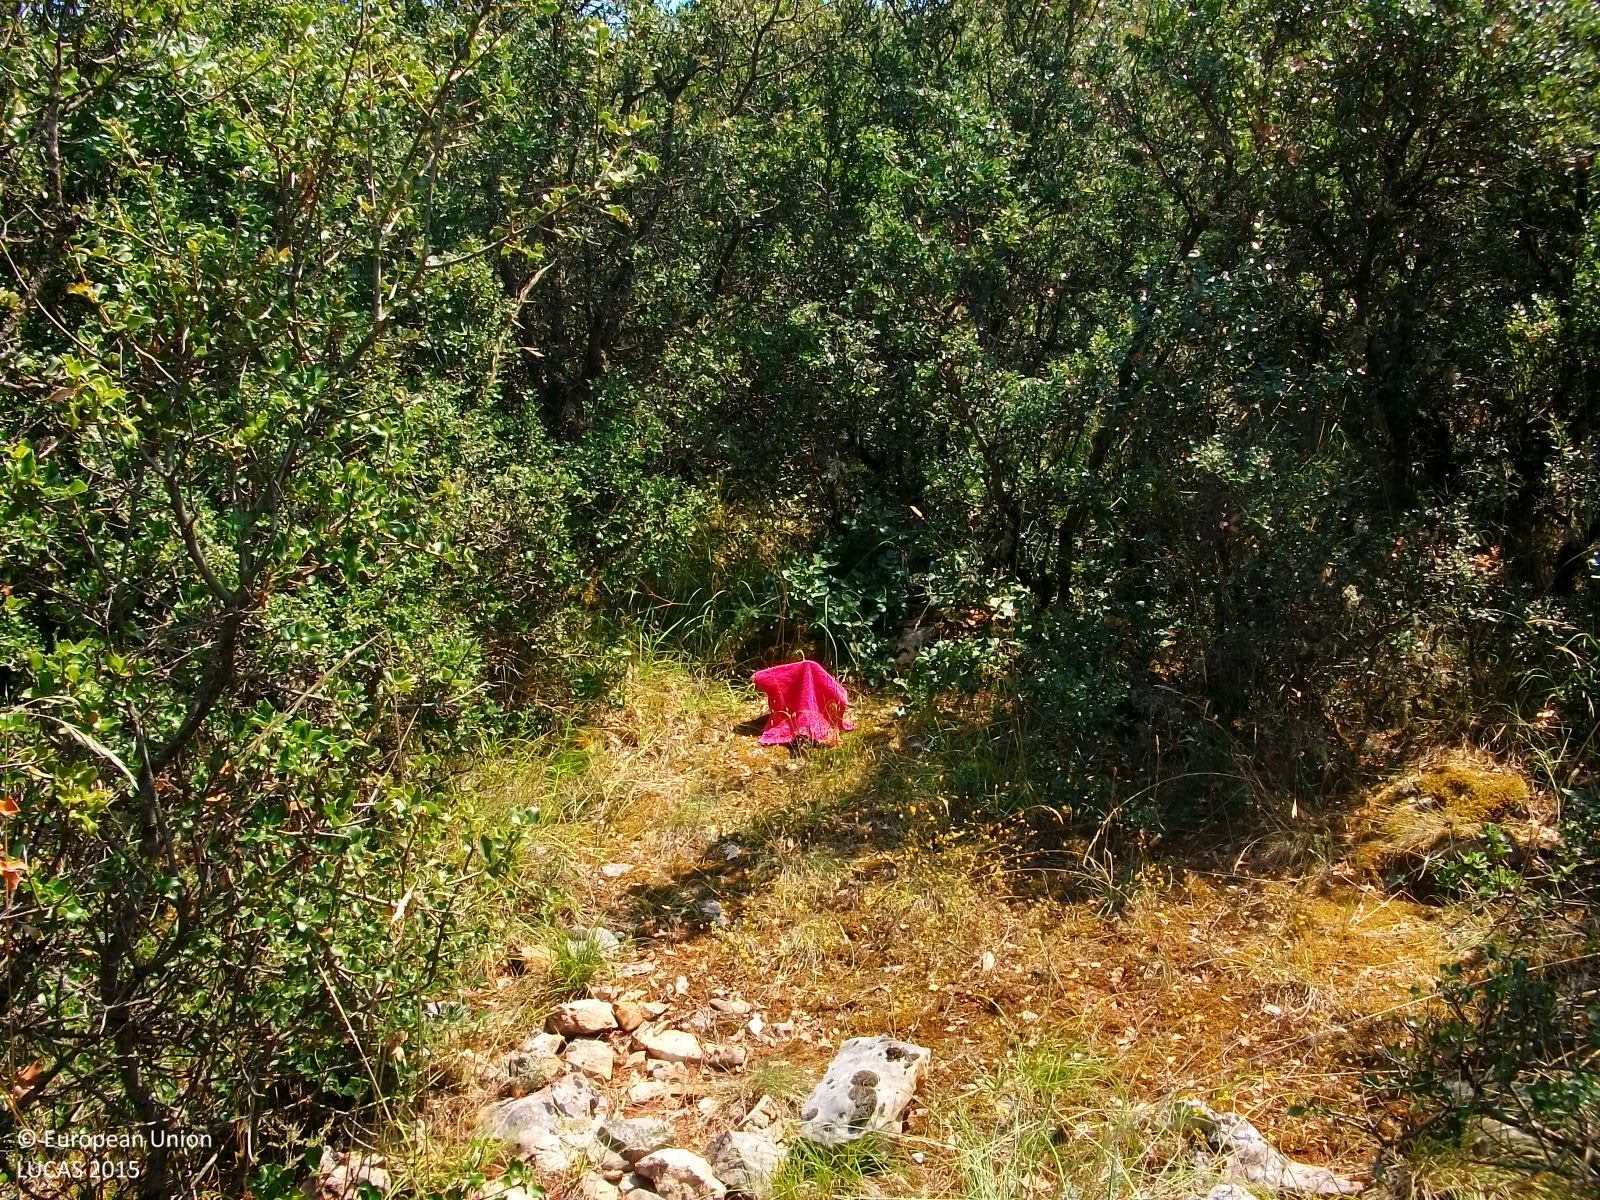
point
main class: Shrubland
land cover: Shrubland with sparse tree cover
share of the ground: > 75 %
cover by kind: shrubs 85 %, broadleaved forest trees 5 %, herbaceous plants 5 %, unconsolidated bare surface 5 %
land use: Agriculture (excluding fallow land and kitchen gardens)
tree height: < 5 m
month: July
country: GR
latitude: 38.6545
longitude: 22.5381
